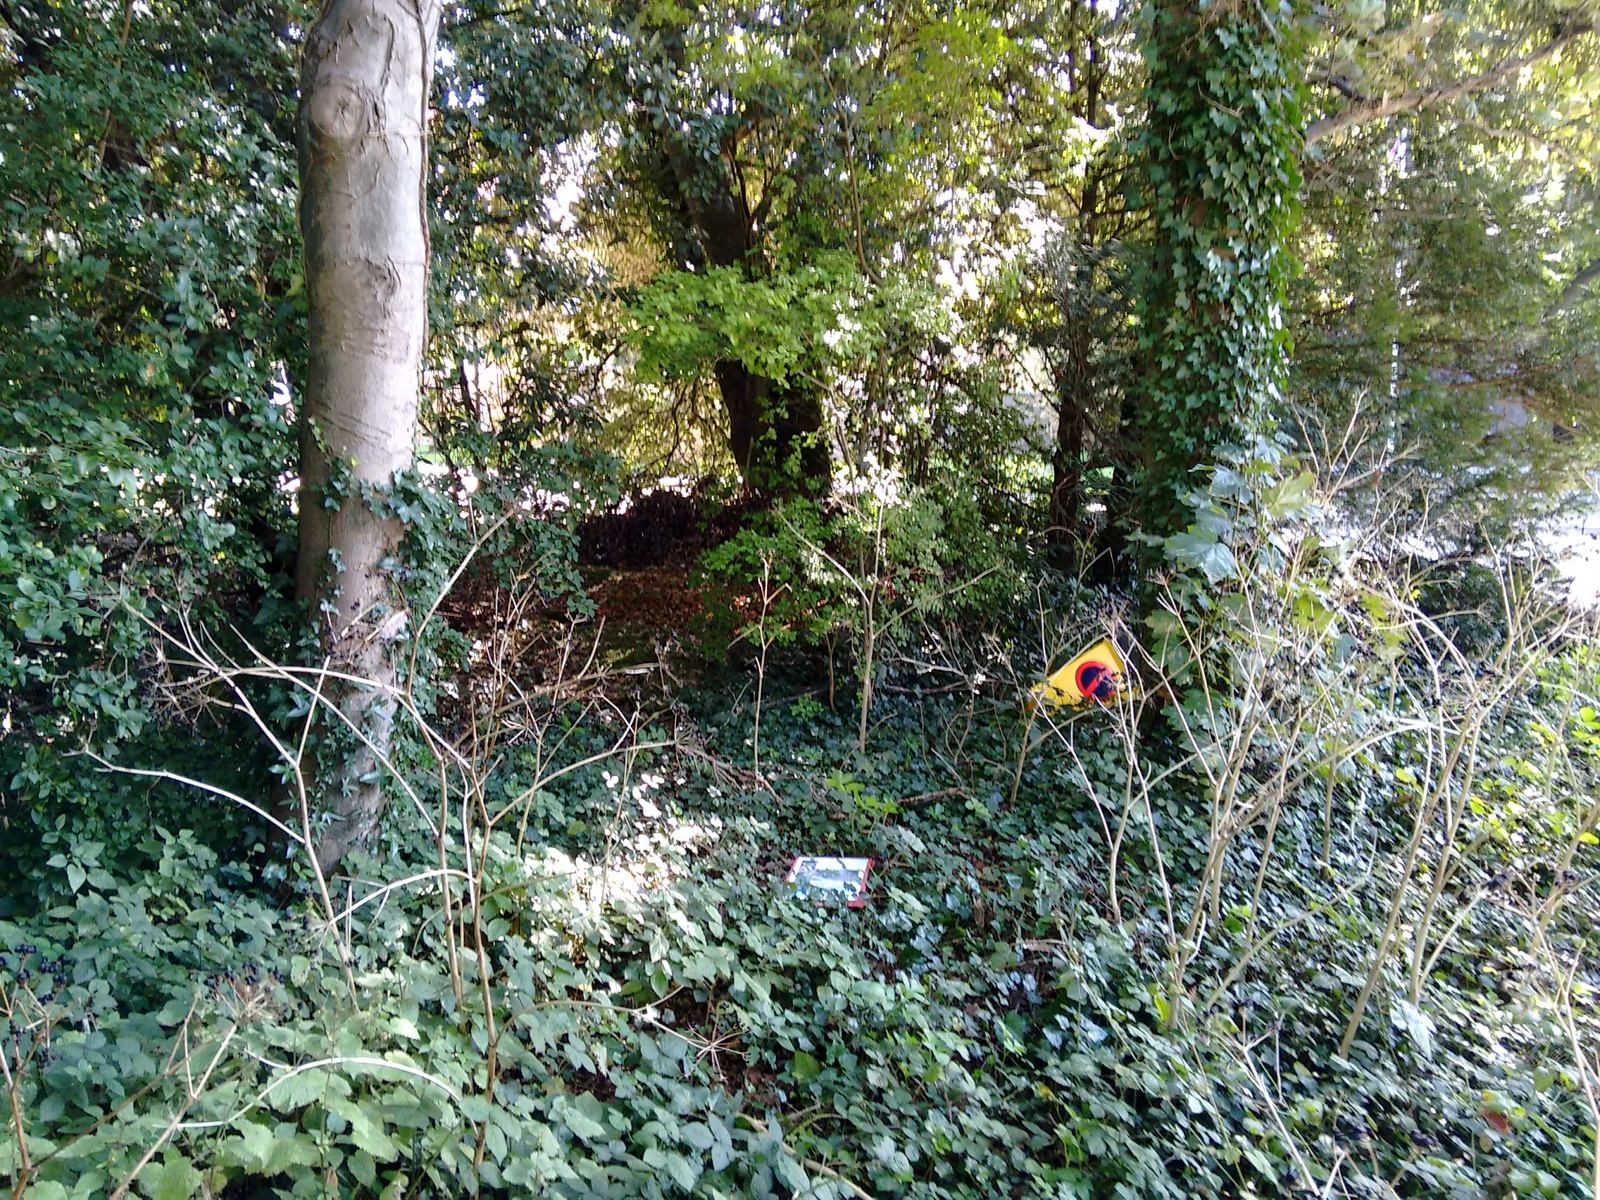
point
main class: Woodland
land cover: Broadleaved woodland
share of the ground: > 75 %
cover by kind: broadleaved forest trees 100 %
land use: Residential
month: September
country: GB
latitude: 52.9262
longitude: 1.3075
